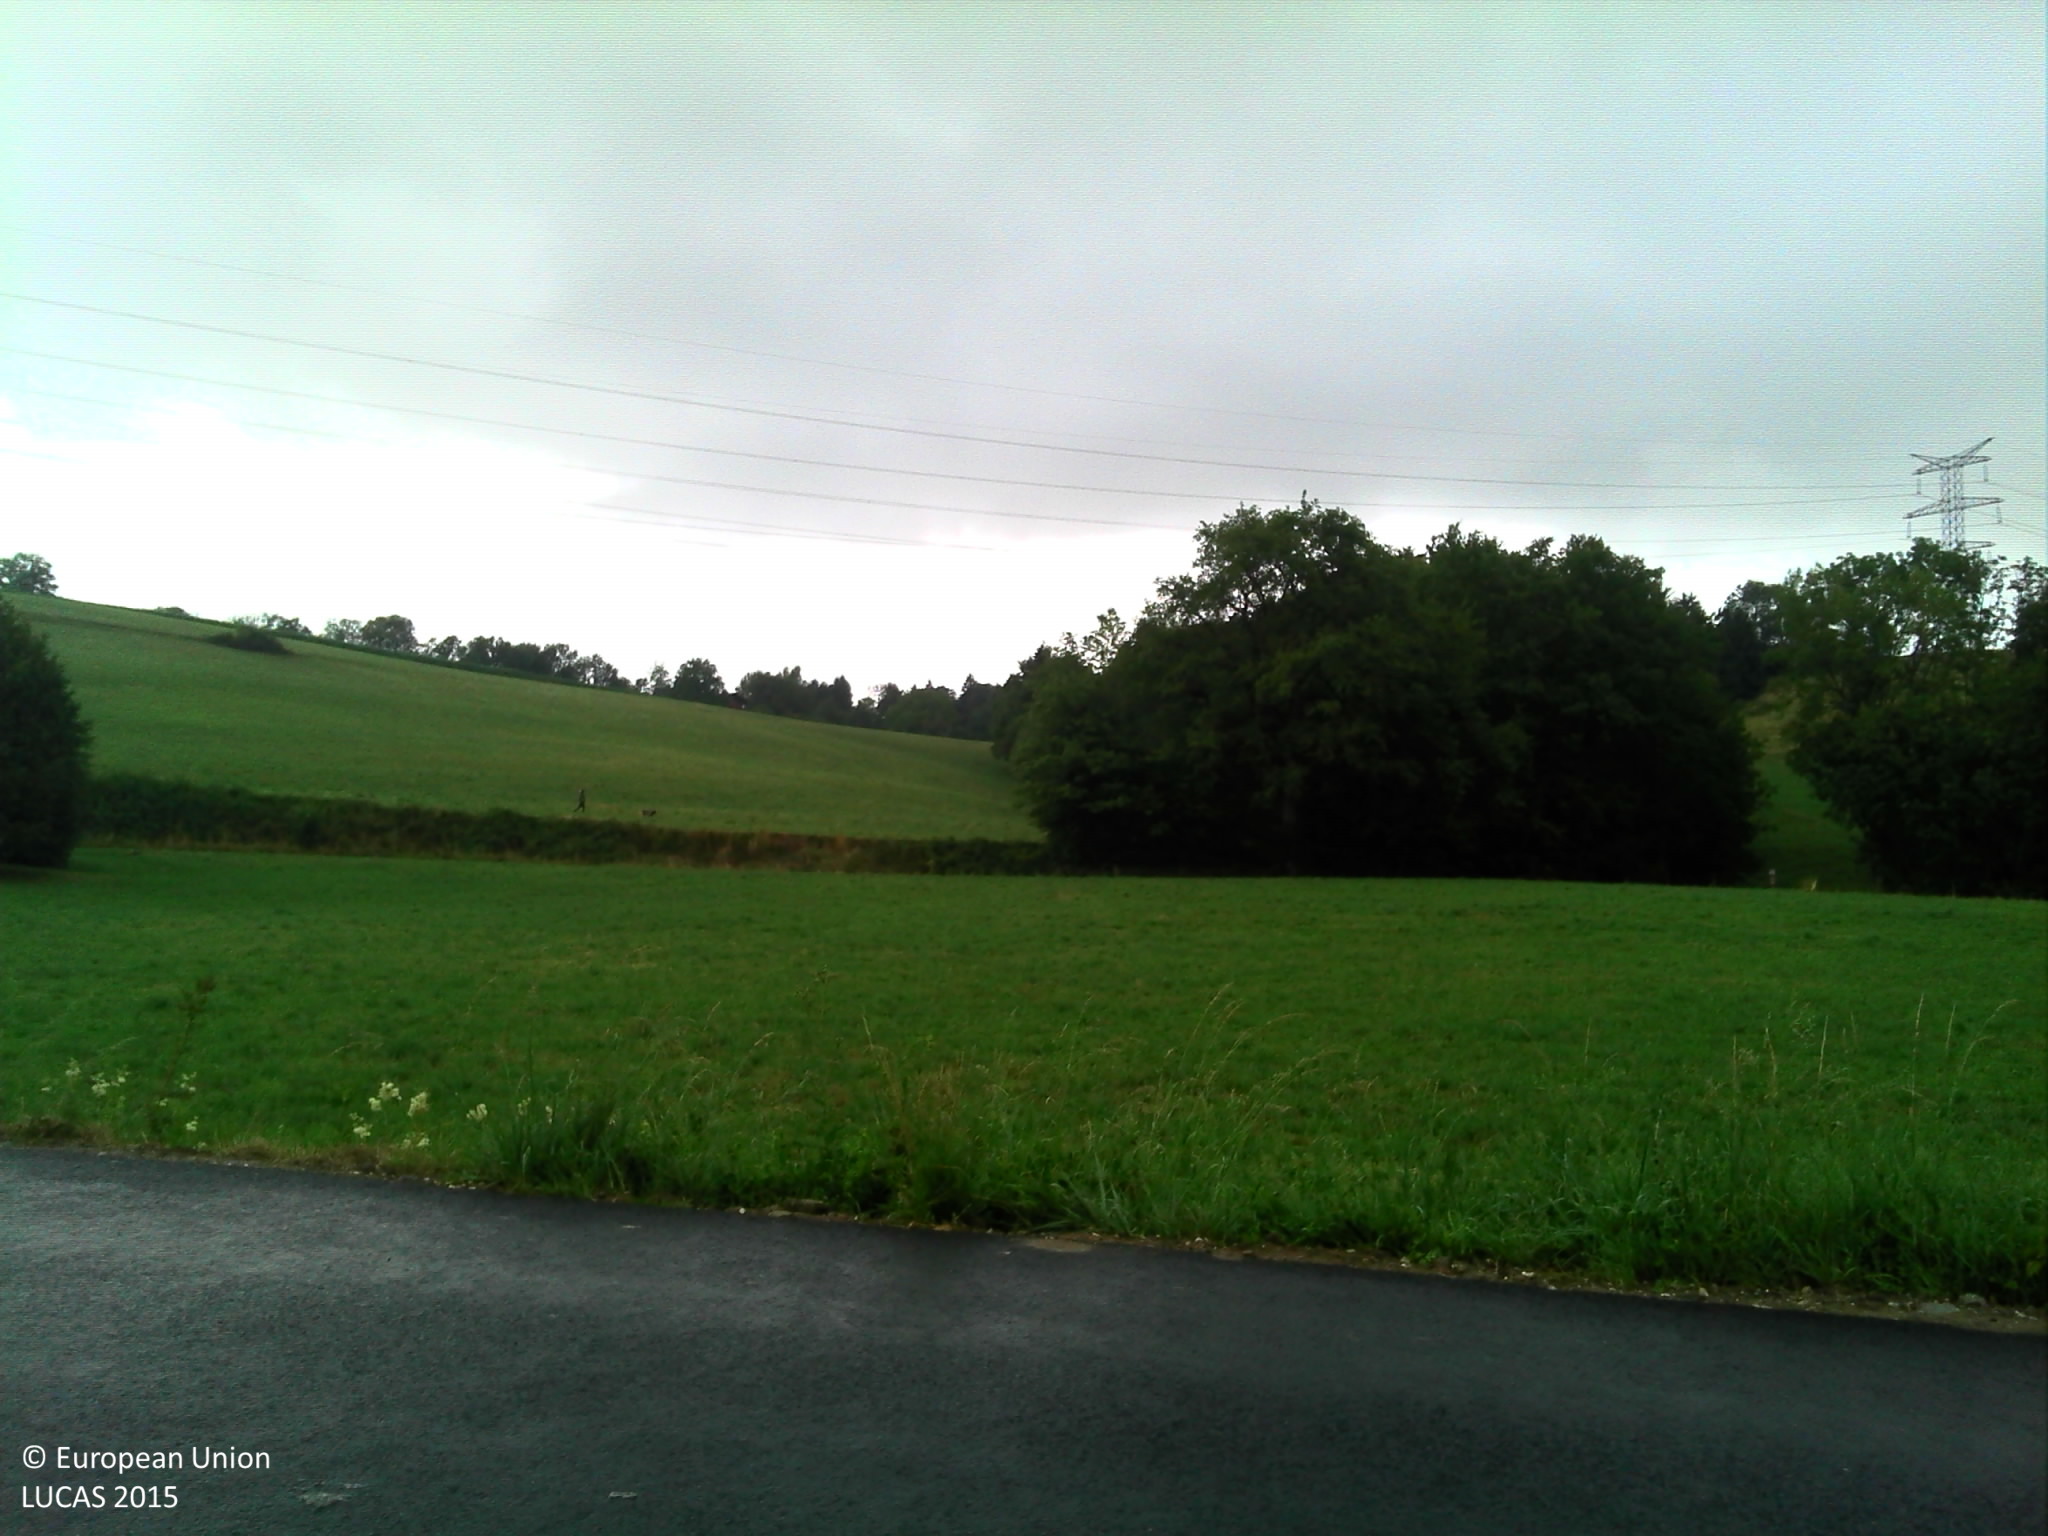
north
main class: Grassland
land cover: Grassland without tree/shrub cover
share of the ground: > 75 %
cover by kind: herbaceous plants 100 %
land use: Agriculture (excluding fallow land and kitchen gardens)
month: July
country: FR
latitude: 46.0490
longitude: 6.1912
